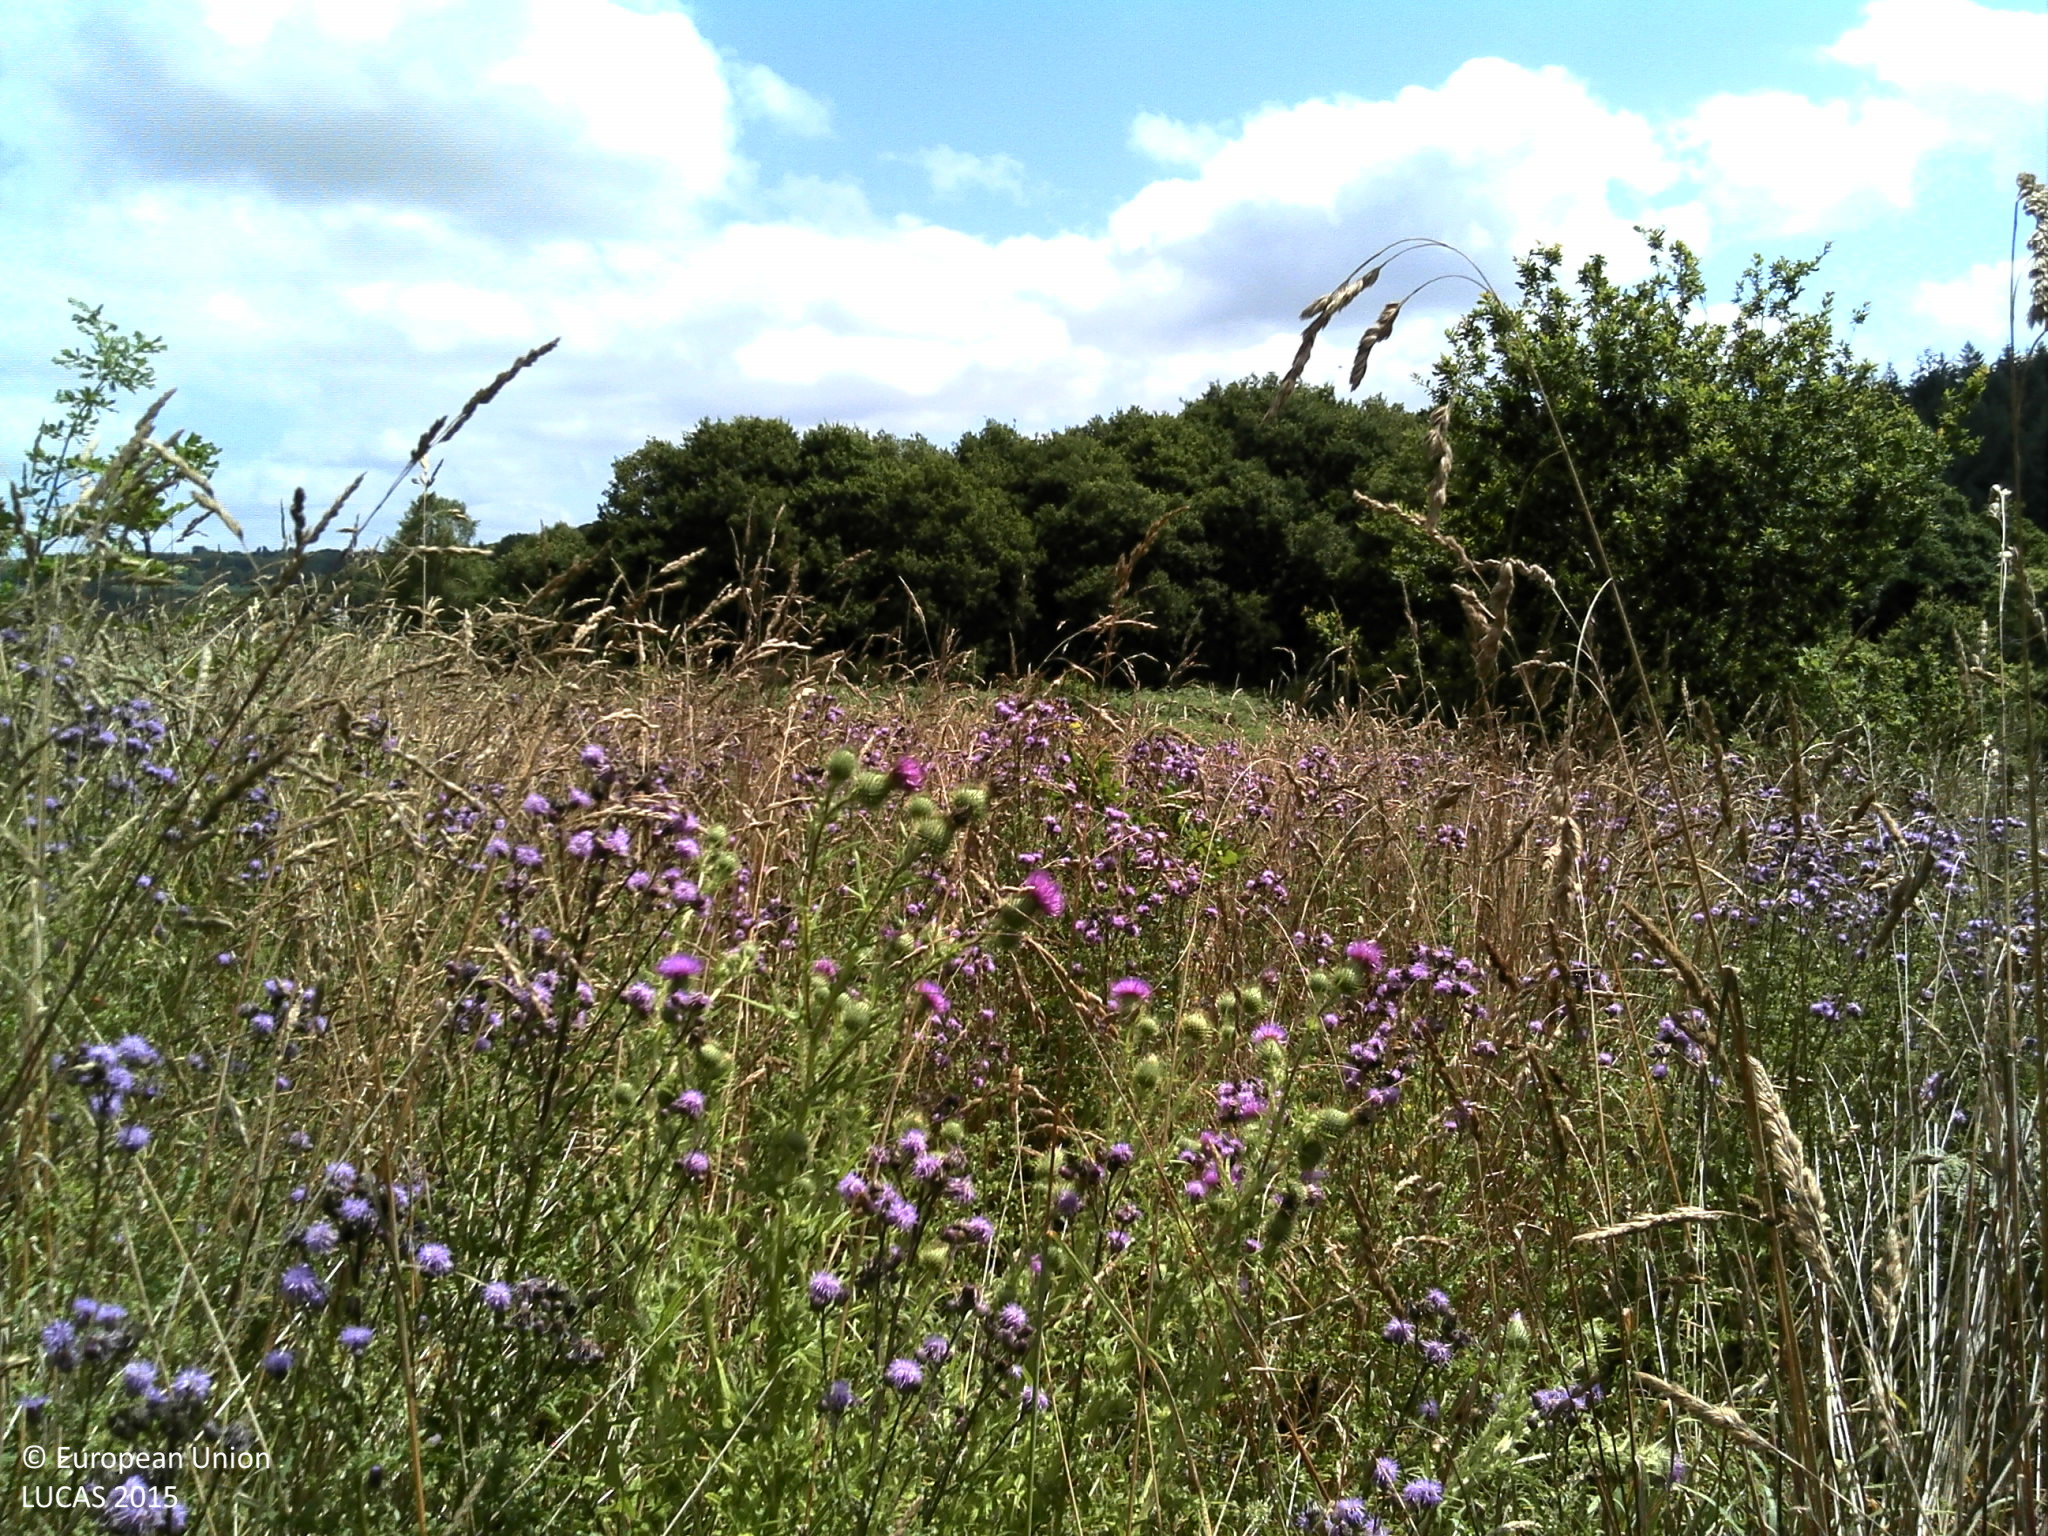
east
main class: Shrubland
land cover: Shrubland with sparse tree cover
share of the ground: > 75 %
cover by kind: shrubs 70 %, herbaceous plants 25 %, broadleaved forest trees 5 %
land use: Semi-natural and natural areas not in use
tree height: > 5 m
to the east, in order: Shrubland with sparse tree cover; Spontaneously vegetated surfaces; Broadleaved woodland; Dry stone walls; Broadleaved woodland; Artificial constructions in urban areas; Broadleaved woodland; Railways; Broadleaved woodland
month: July
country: FR
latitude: 48.0590
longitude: -4.1104
